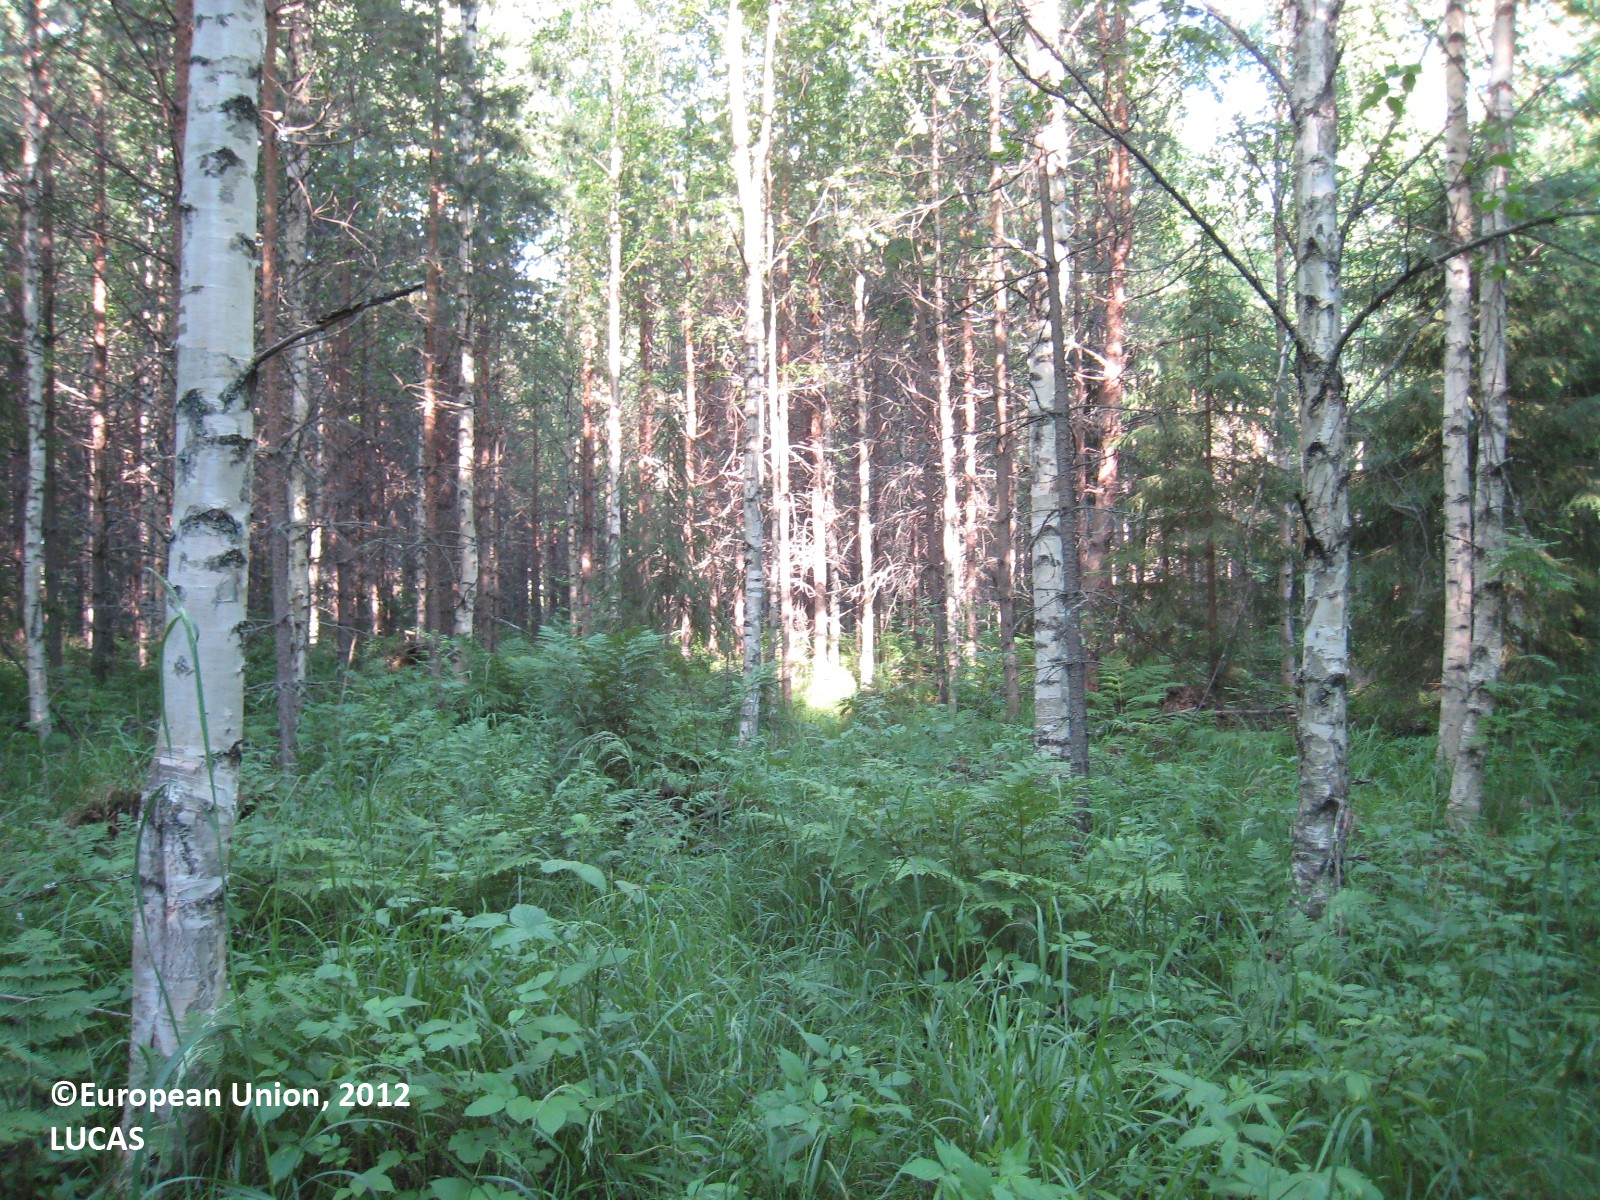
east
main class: Woodland
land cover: Other mixed woodland
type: boreal forest
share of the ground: > 75 %
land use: Forestry
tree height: > 5 m
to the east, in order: Other mixed woodland; Ditches and canals; Pine dominated mixed woodland; Ditches and canals; Pine dominated mixed woodland; Ditches and canals; Pine dominated mixed woodland; Ditches and canals; Other mixed woodland; Ditches and canals; Other mixed woodland; Ditches and canals; Spruce dominated mixed woodland; Ditches and canals; Spruce dominated mixed woodland; Broadleaved woodland; Ditches and canals; Managed hedges; Paved roads, cycling and walking lanes; Shrubland with sparse tree cover; Spruce dominated coniferous woodland
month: July
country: FI
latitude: 63.1190
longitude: 25.7936
